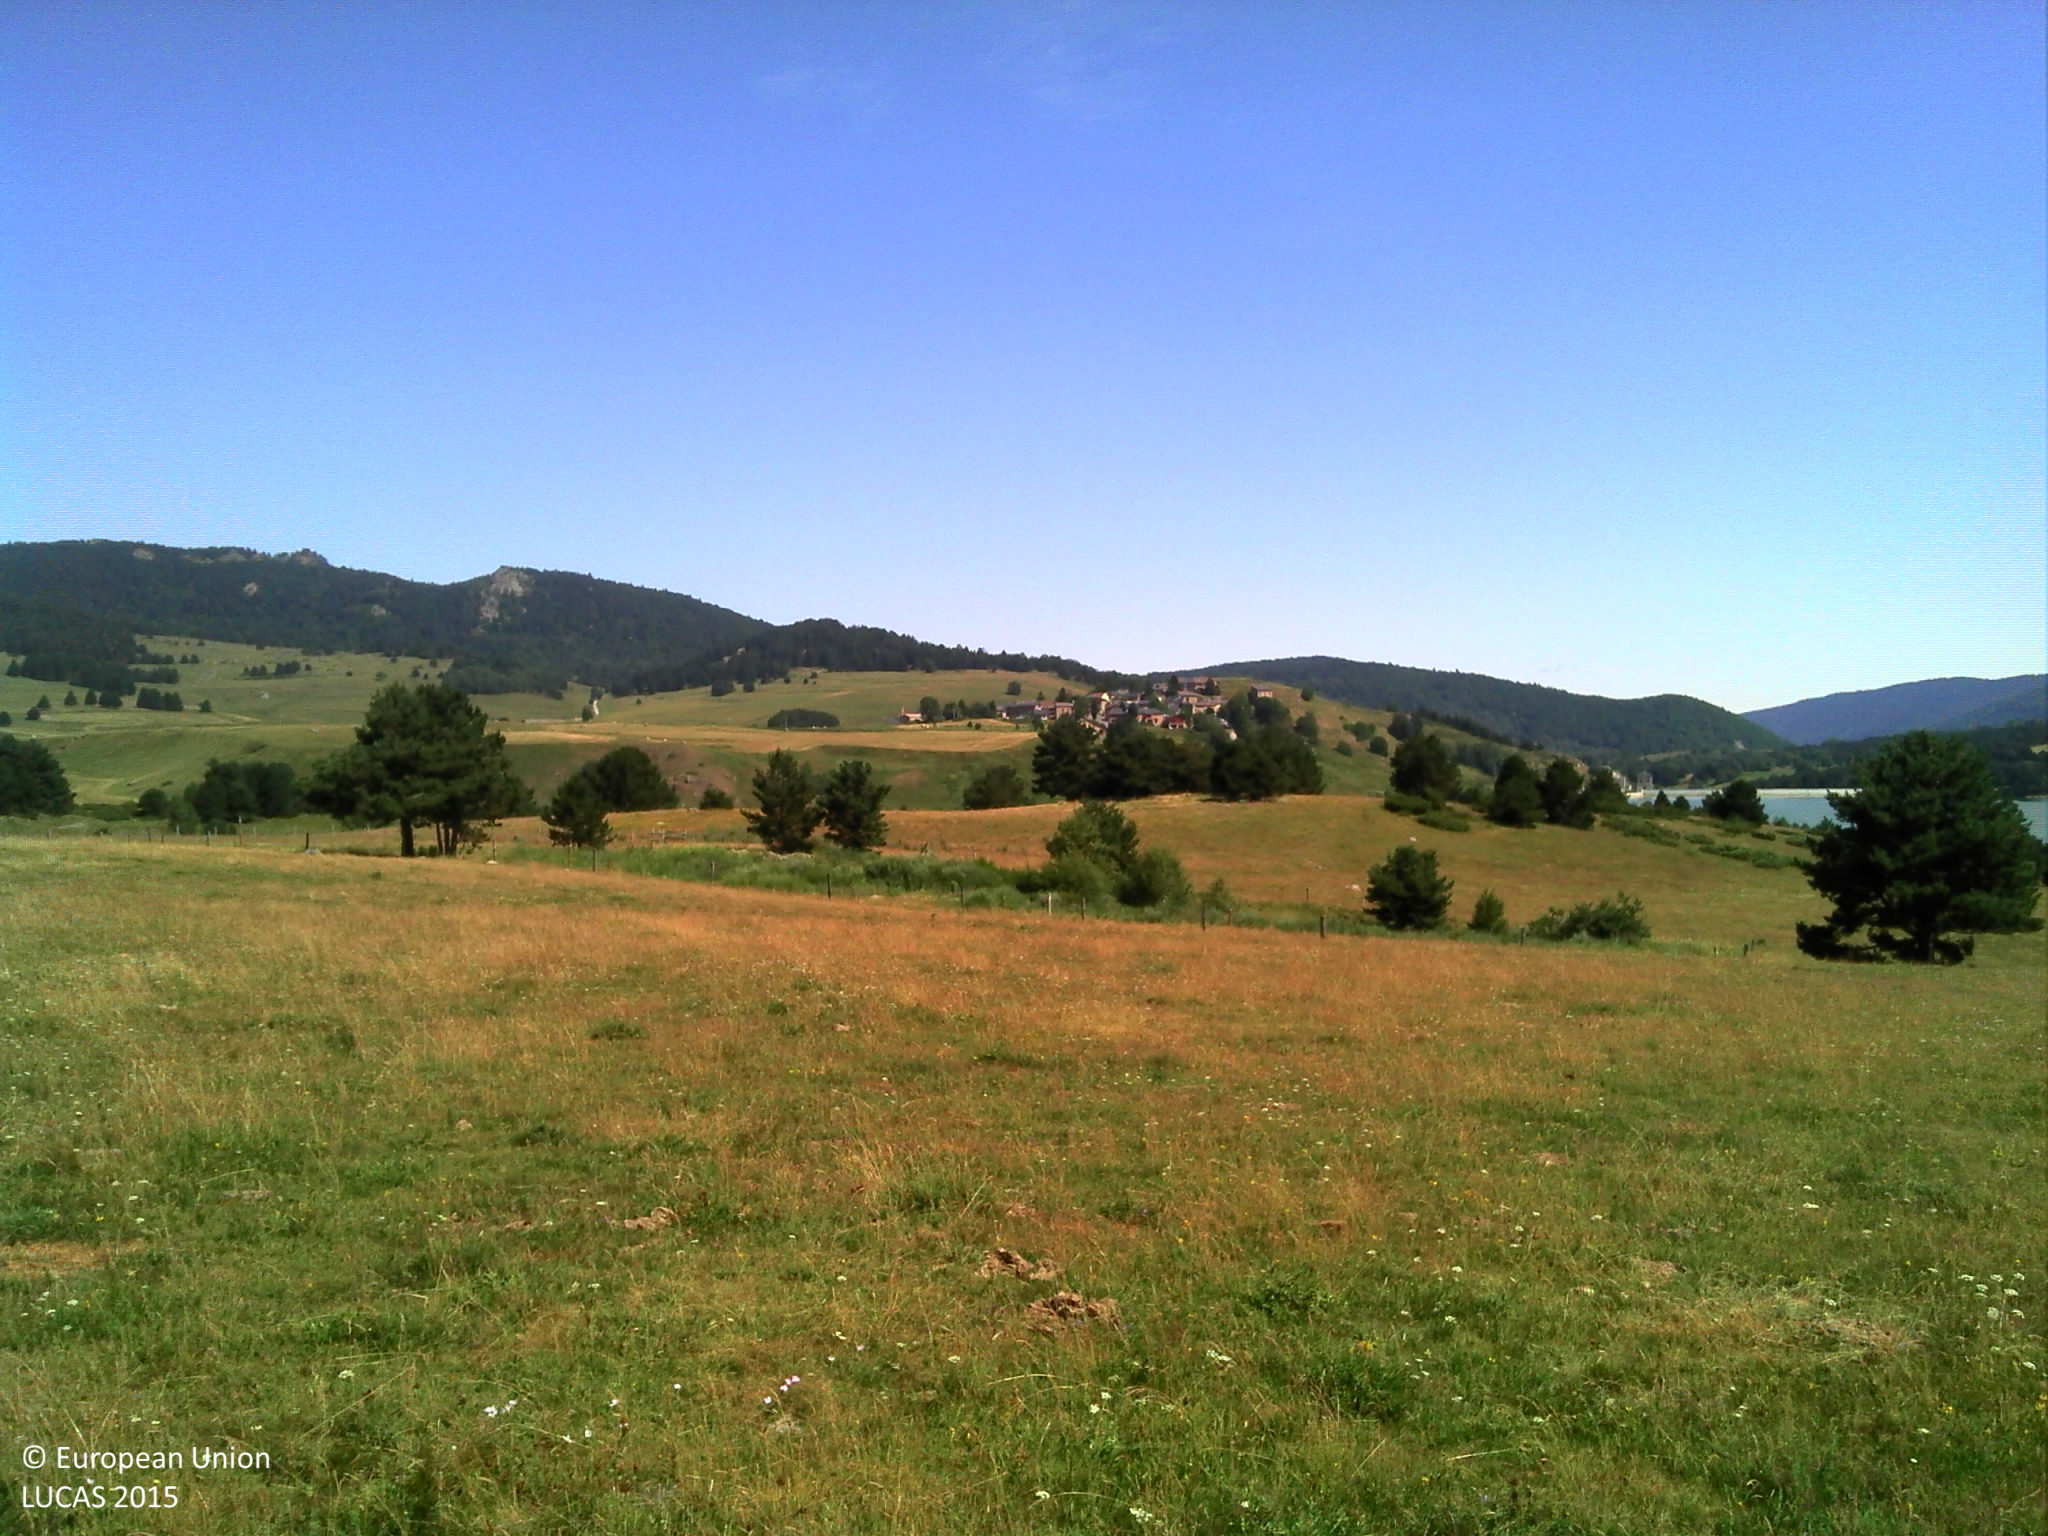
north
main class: Grassland
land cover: Grassland without tree/shrub cover
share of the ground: > 75 %
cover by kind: herbaceous plants 100 %
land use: Agriculture (excluding fallow land and kitchen gardens)
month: July
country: FR
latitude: 42.6369
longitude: 2.1202
